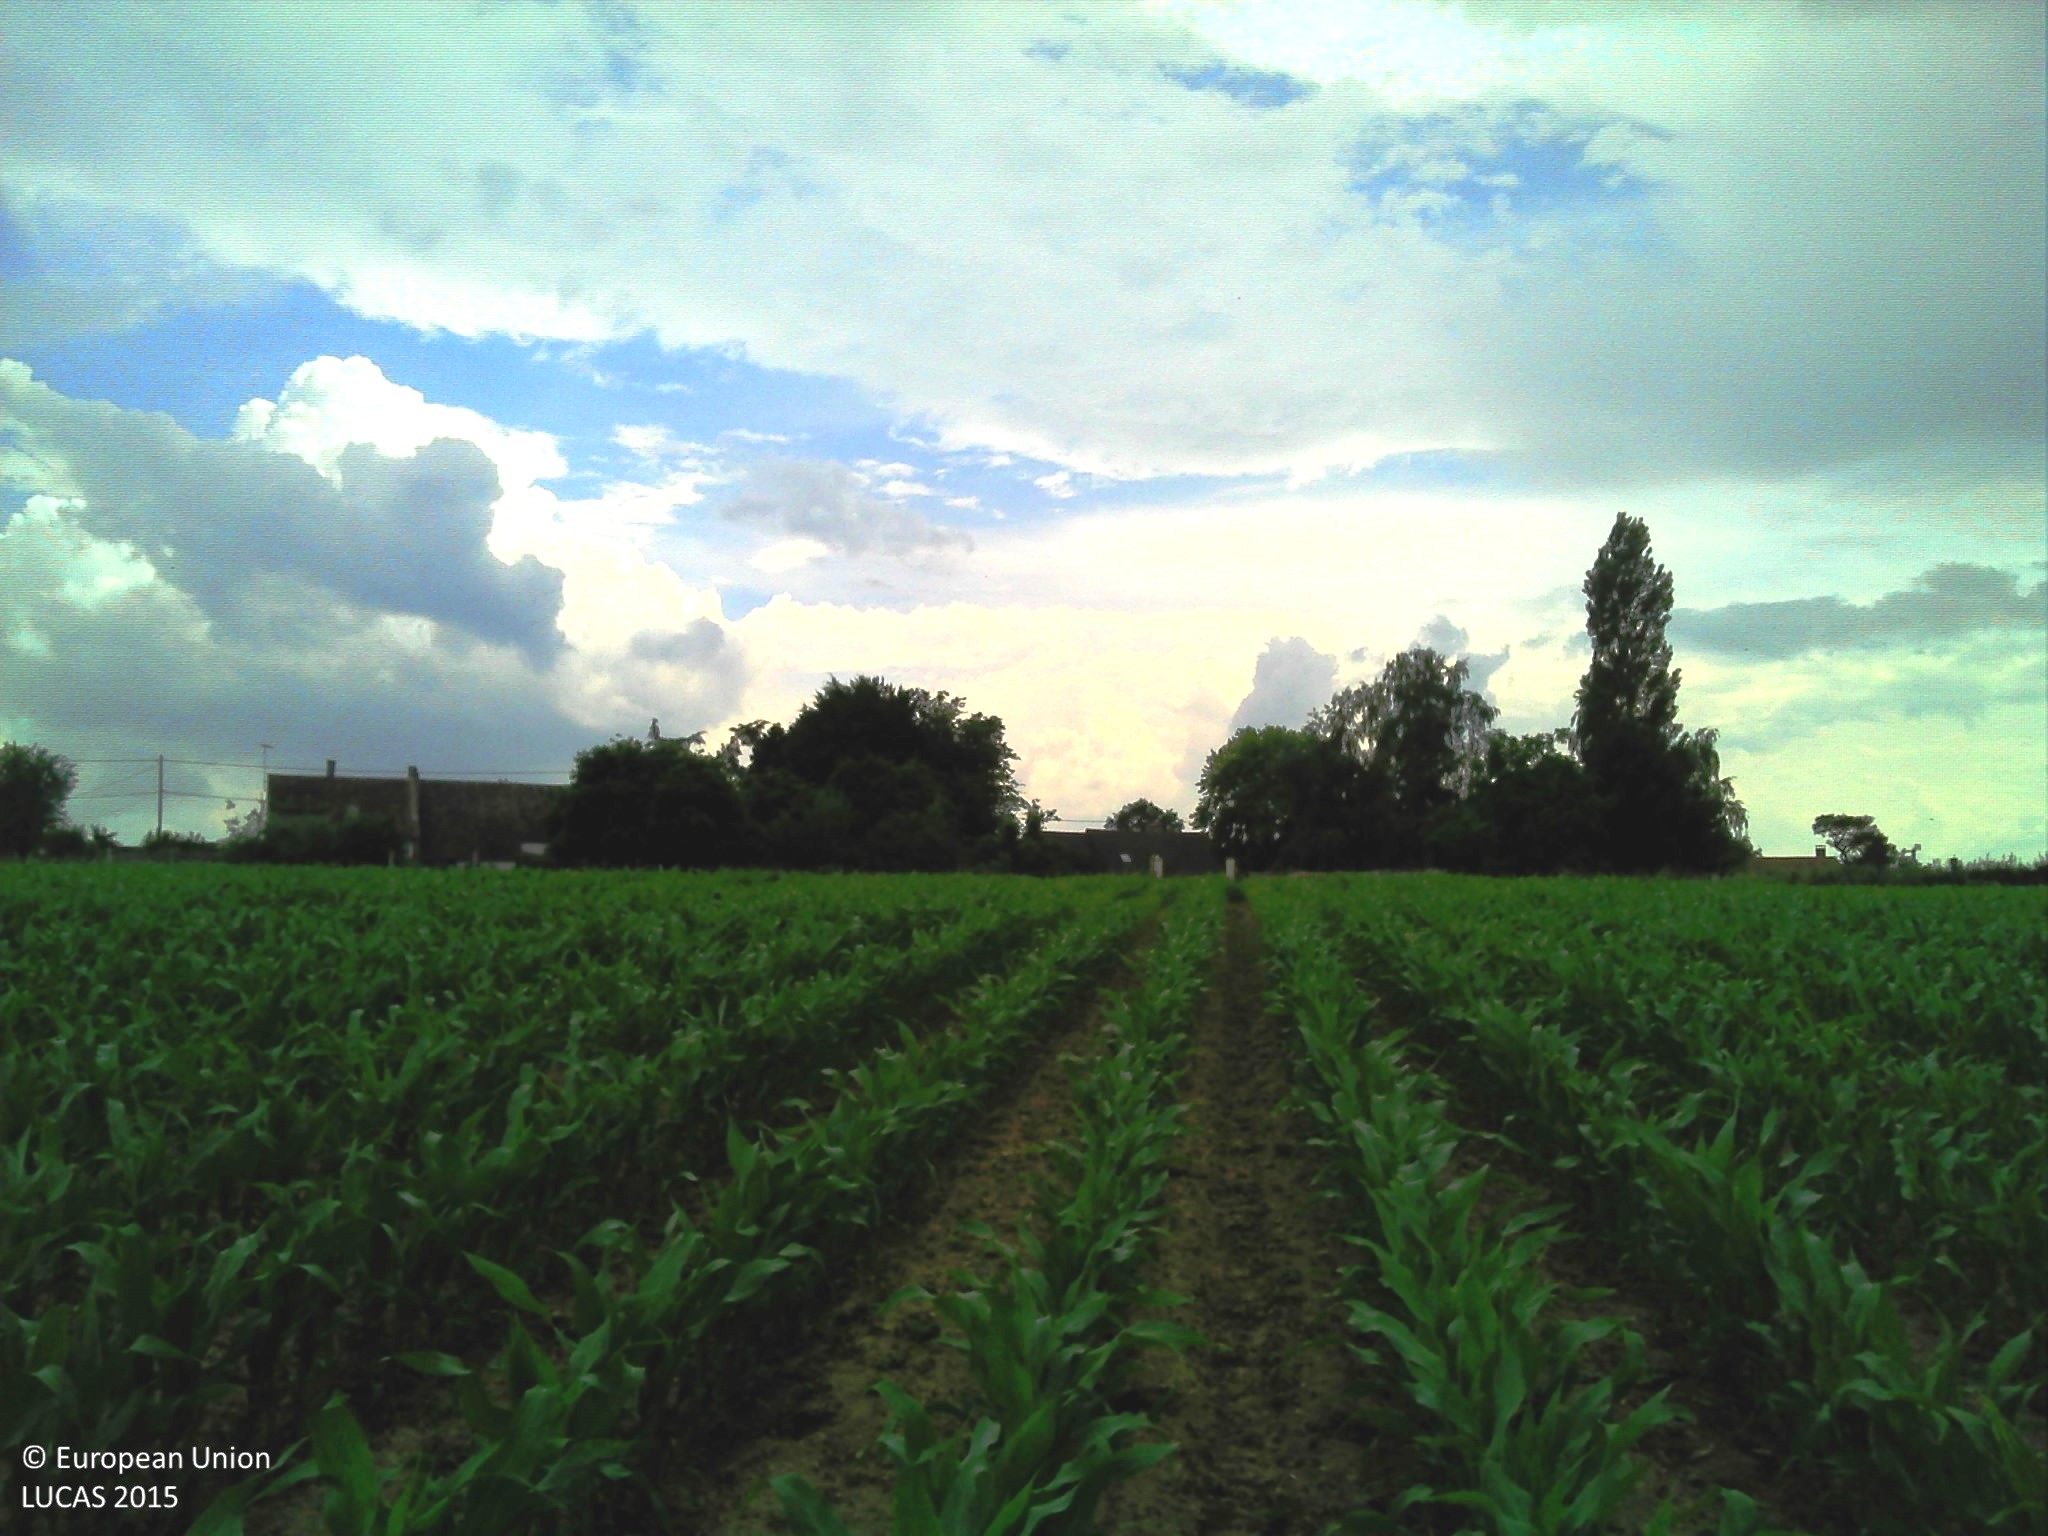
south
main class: Cropland
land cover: Maize
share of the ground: 25 - 50 %
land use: Agriculture (excluding fallow land and kitchen gardens)
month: June
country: FR
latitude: 46.3238
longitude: 3.0491
